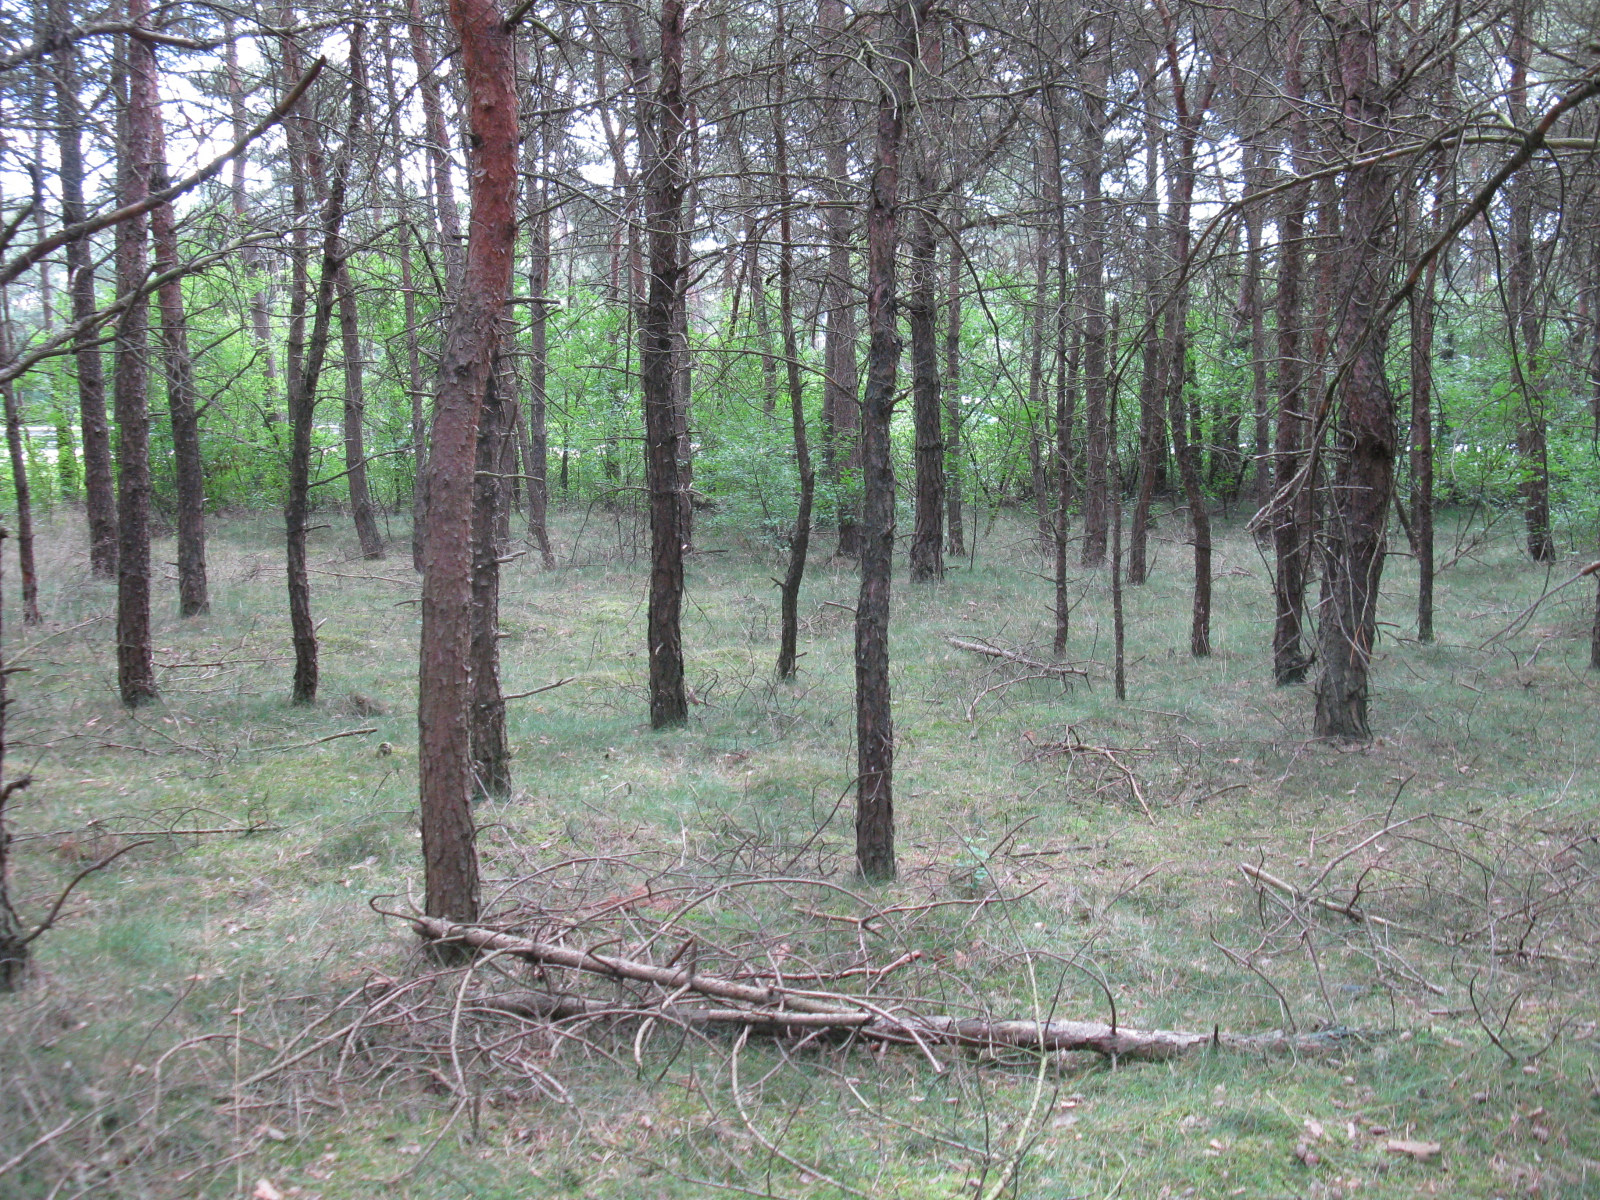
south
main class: Woodland
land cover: Pine dominated coniferous woodland
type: hemiboreal forest and nemoral coniferous forest and mixed broadleaved-coniferous forest
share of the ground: > 75 %
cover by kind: coniferous forest trees 100 %
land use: Forestry
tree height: > 5 m
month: July
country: DE
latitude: 52.9053
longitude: 8.3502
